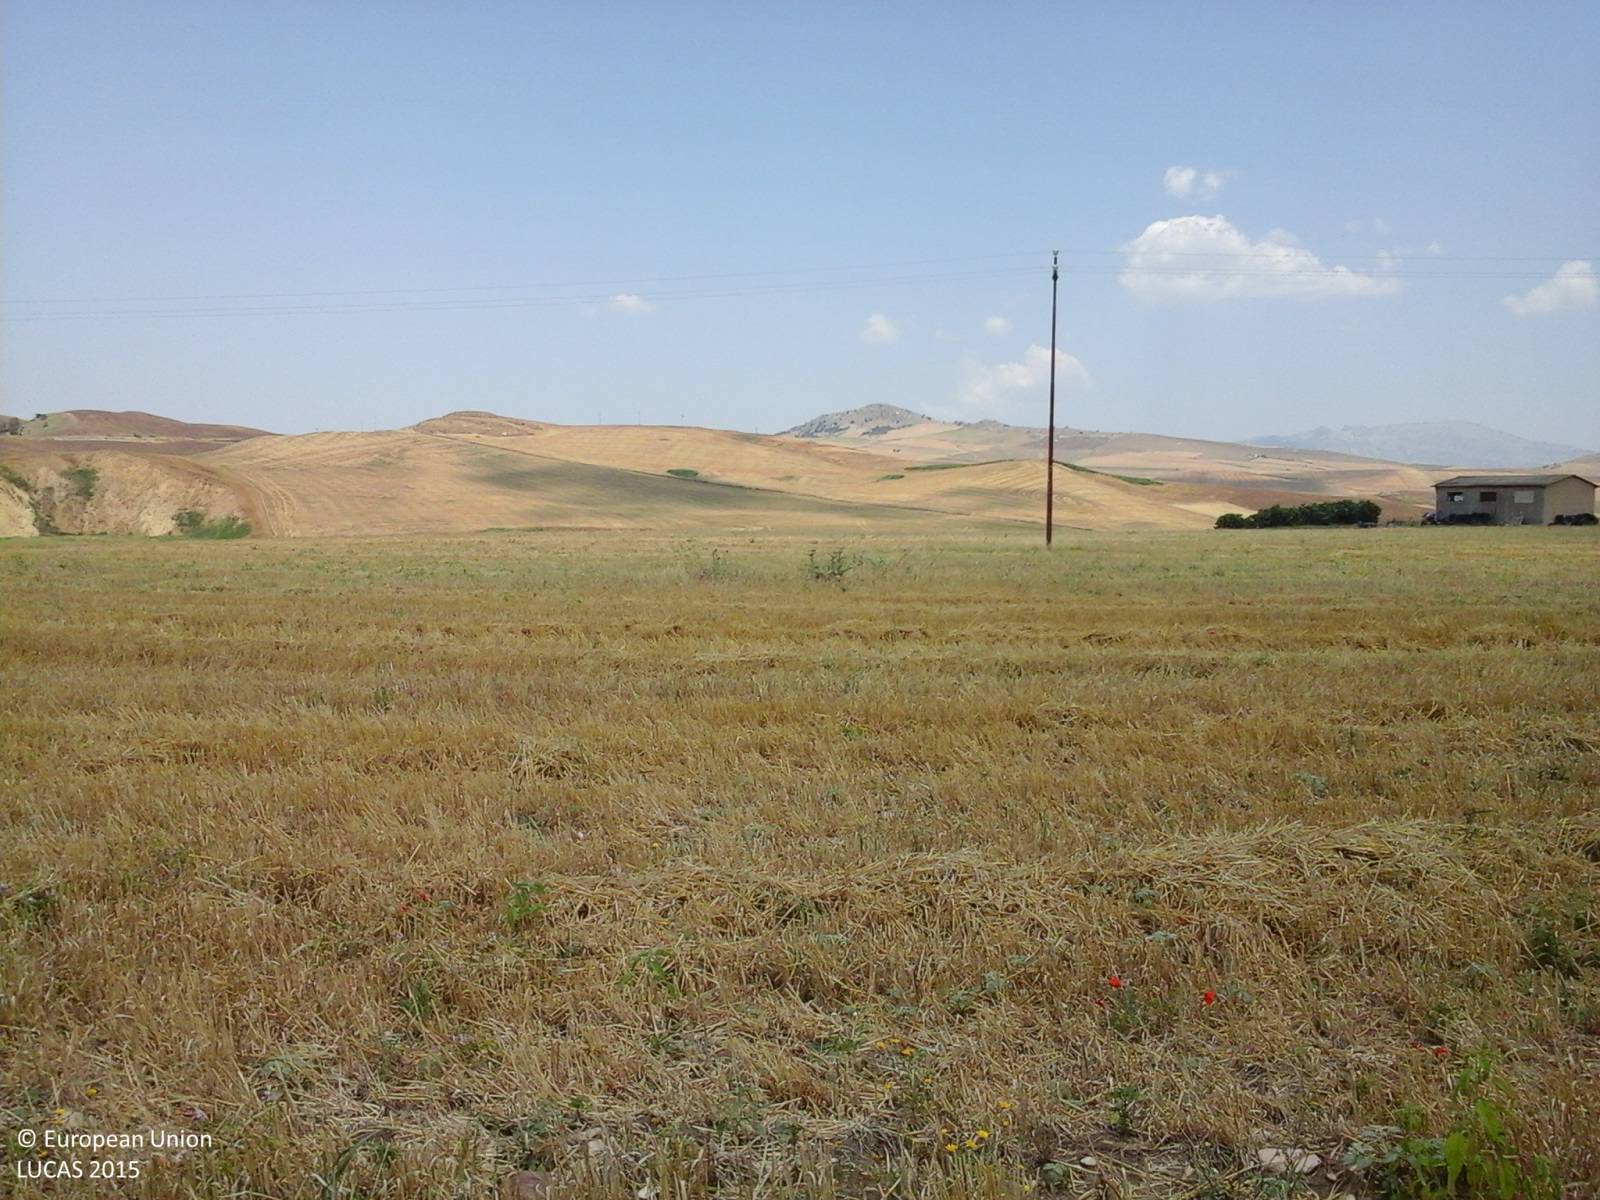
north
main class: Cropland
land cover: Barley
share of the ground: > 75 %
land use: Agriculture (excluding fallow land and kitchen gardens)
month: July
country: IT
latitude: 37.8212
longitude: 13.1916
